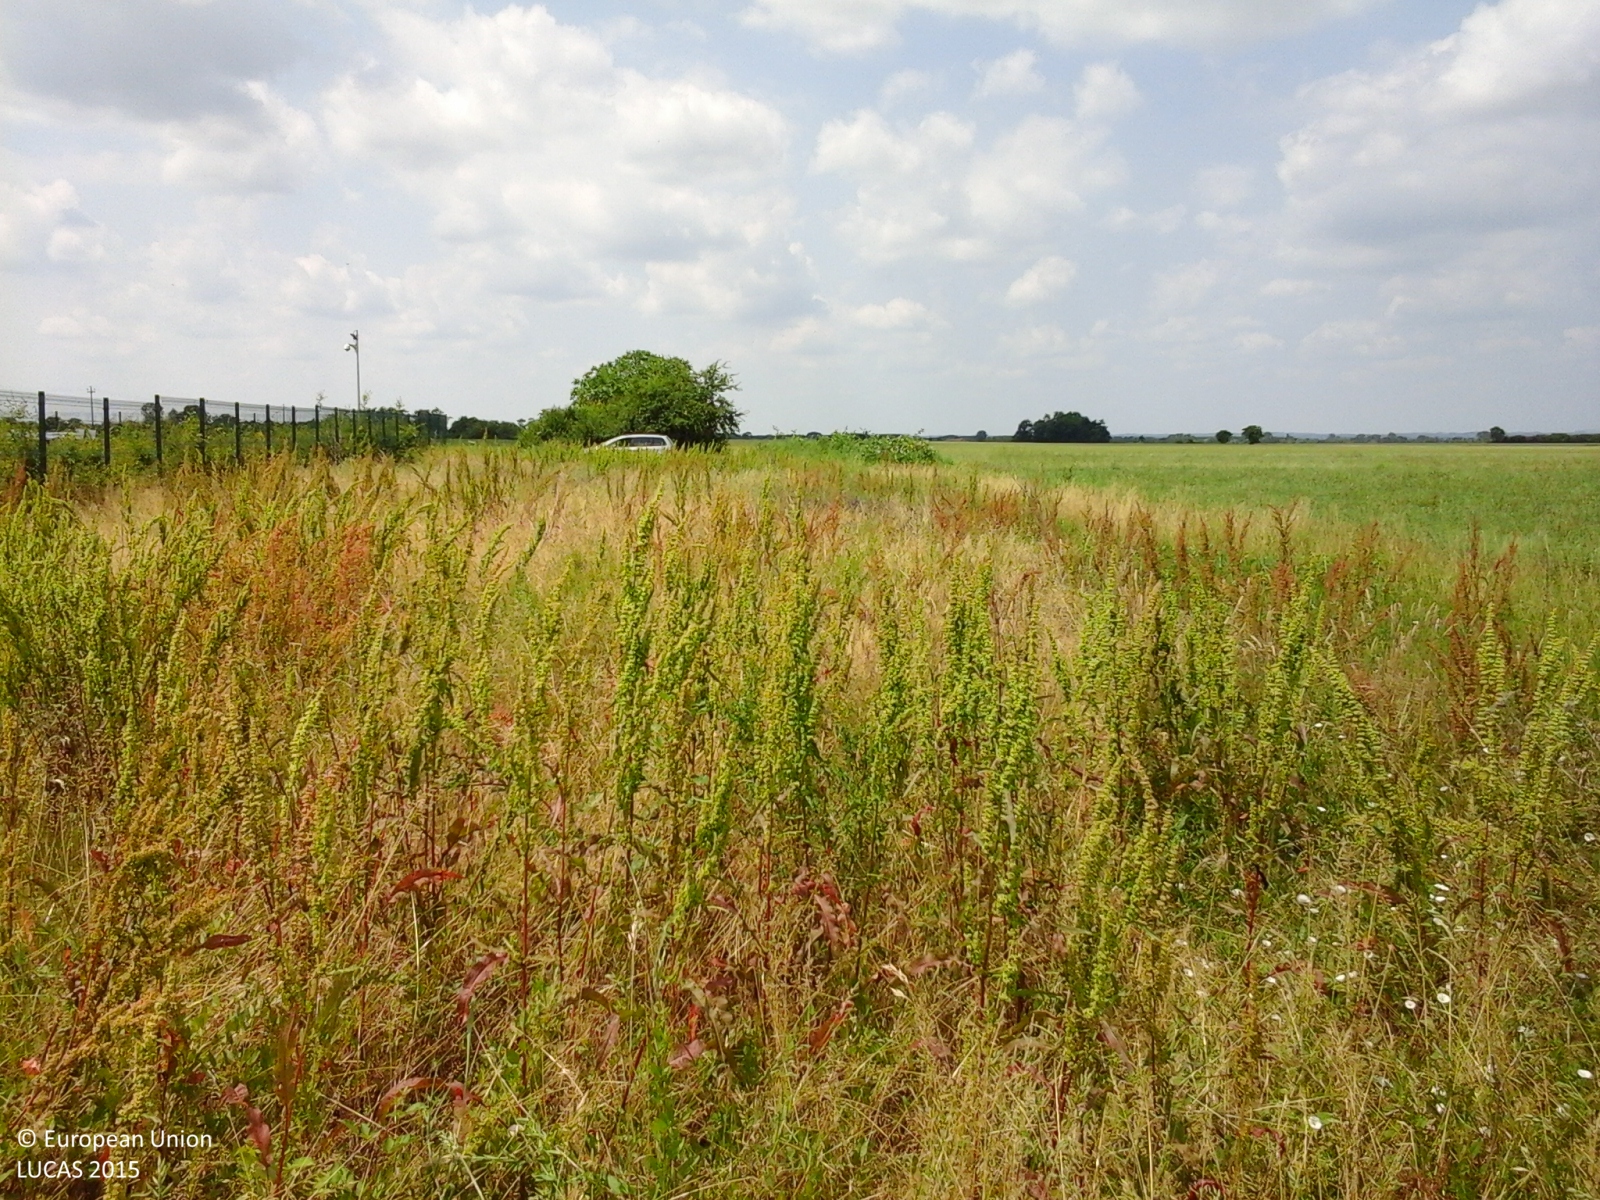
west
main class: Grassland
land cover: Spontaneously vegetated surfaces
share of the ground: > 75 %
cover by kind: herbaceous plants 100 %
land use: Fallow land
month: May
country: IT
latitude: 44.8631
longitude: 8.5222
